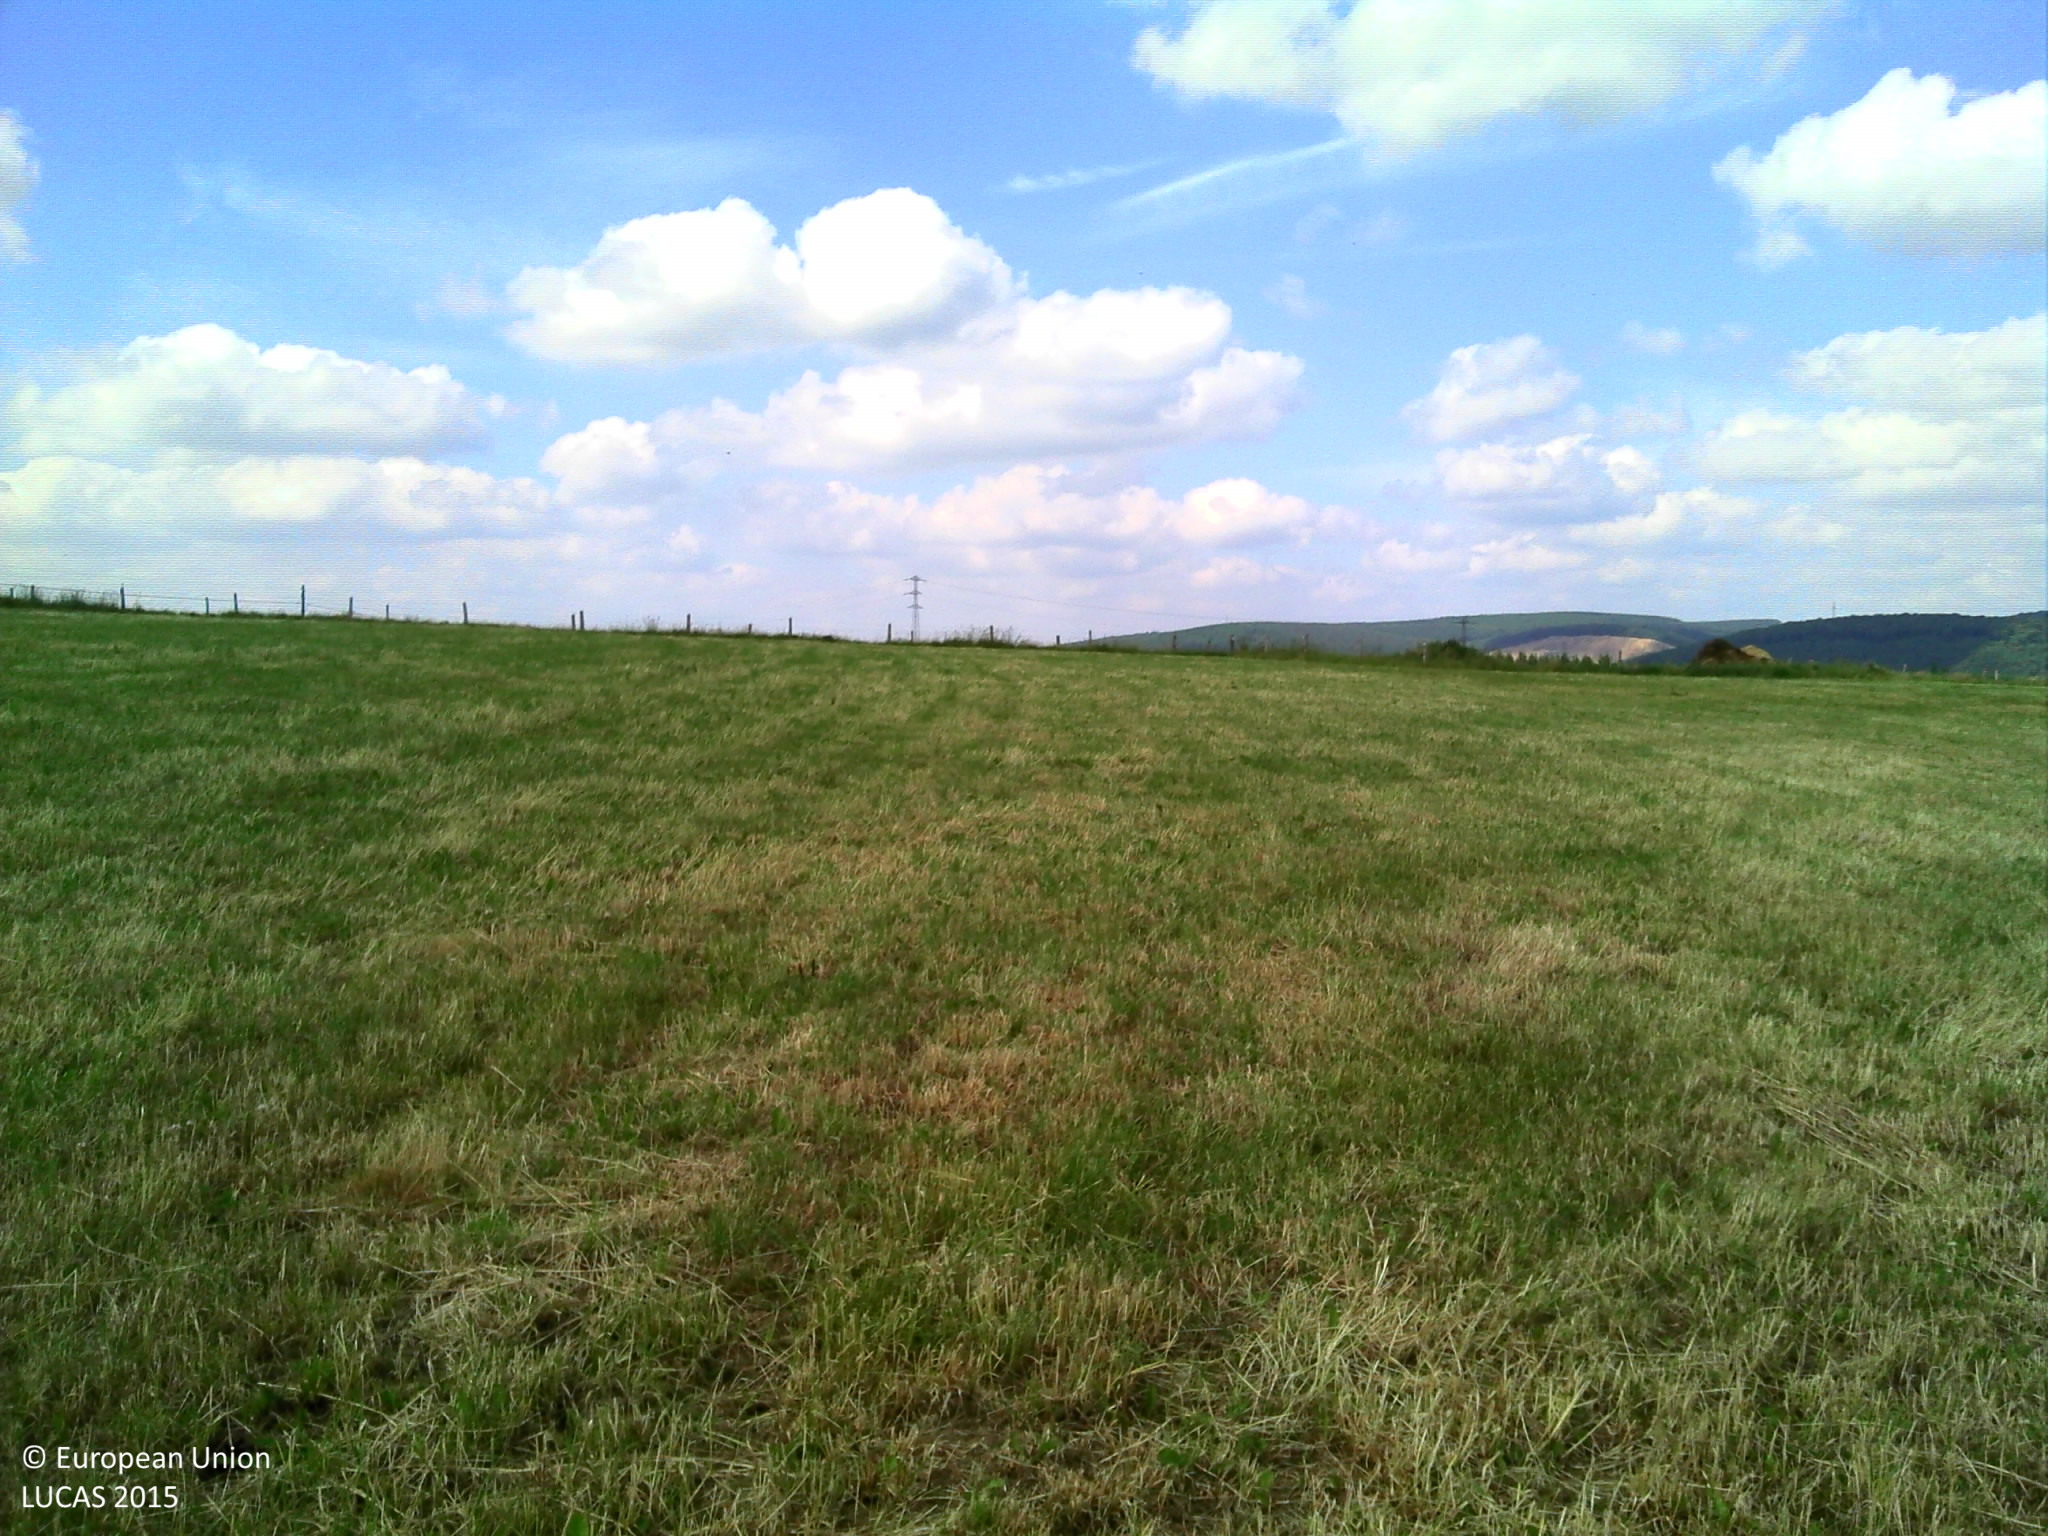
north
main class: Grassland
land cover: Grassland without tree/shrub cover
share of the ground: > 75 %
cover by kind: herbaceous plants 100 %
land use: Agriculture (excluding fallow land and kitchen gardens)
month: June
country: BE
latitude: 50.1699
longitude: 5.5602
